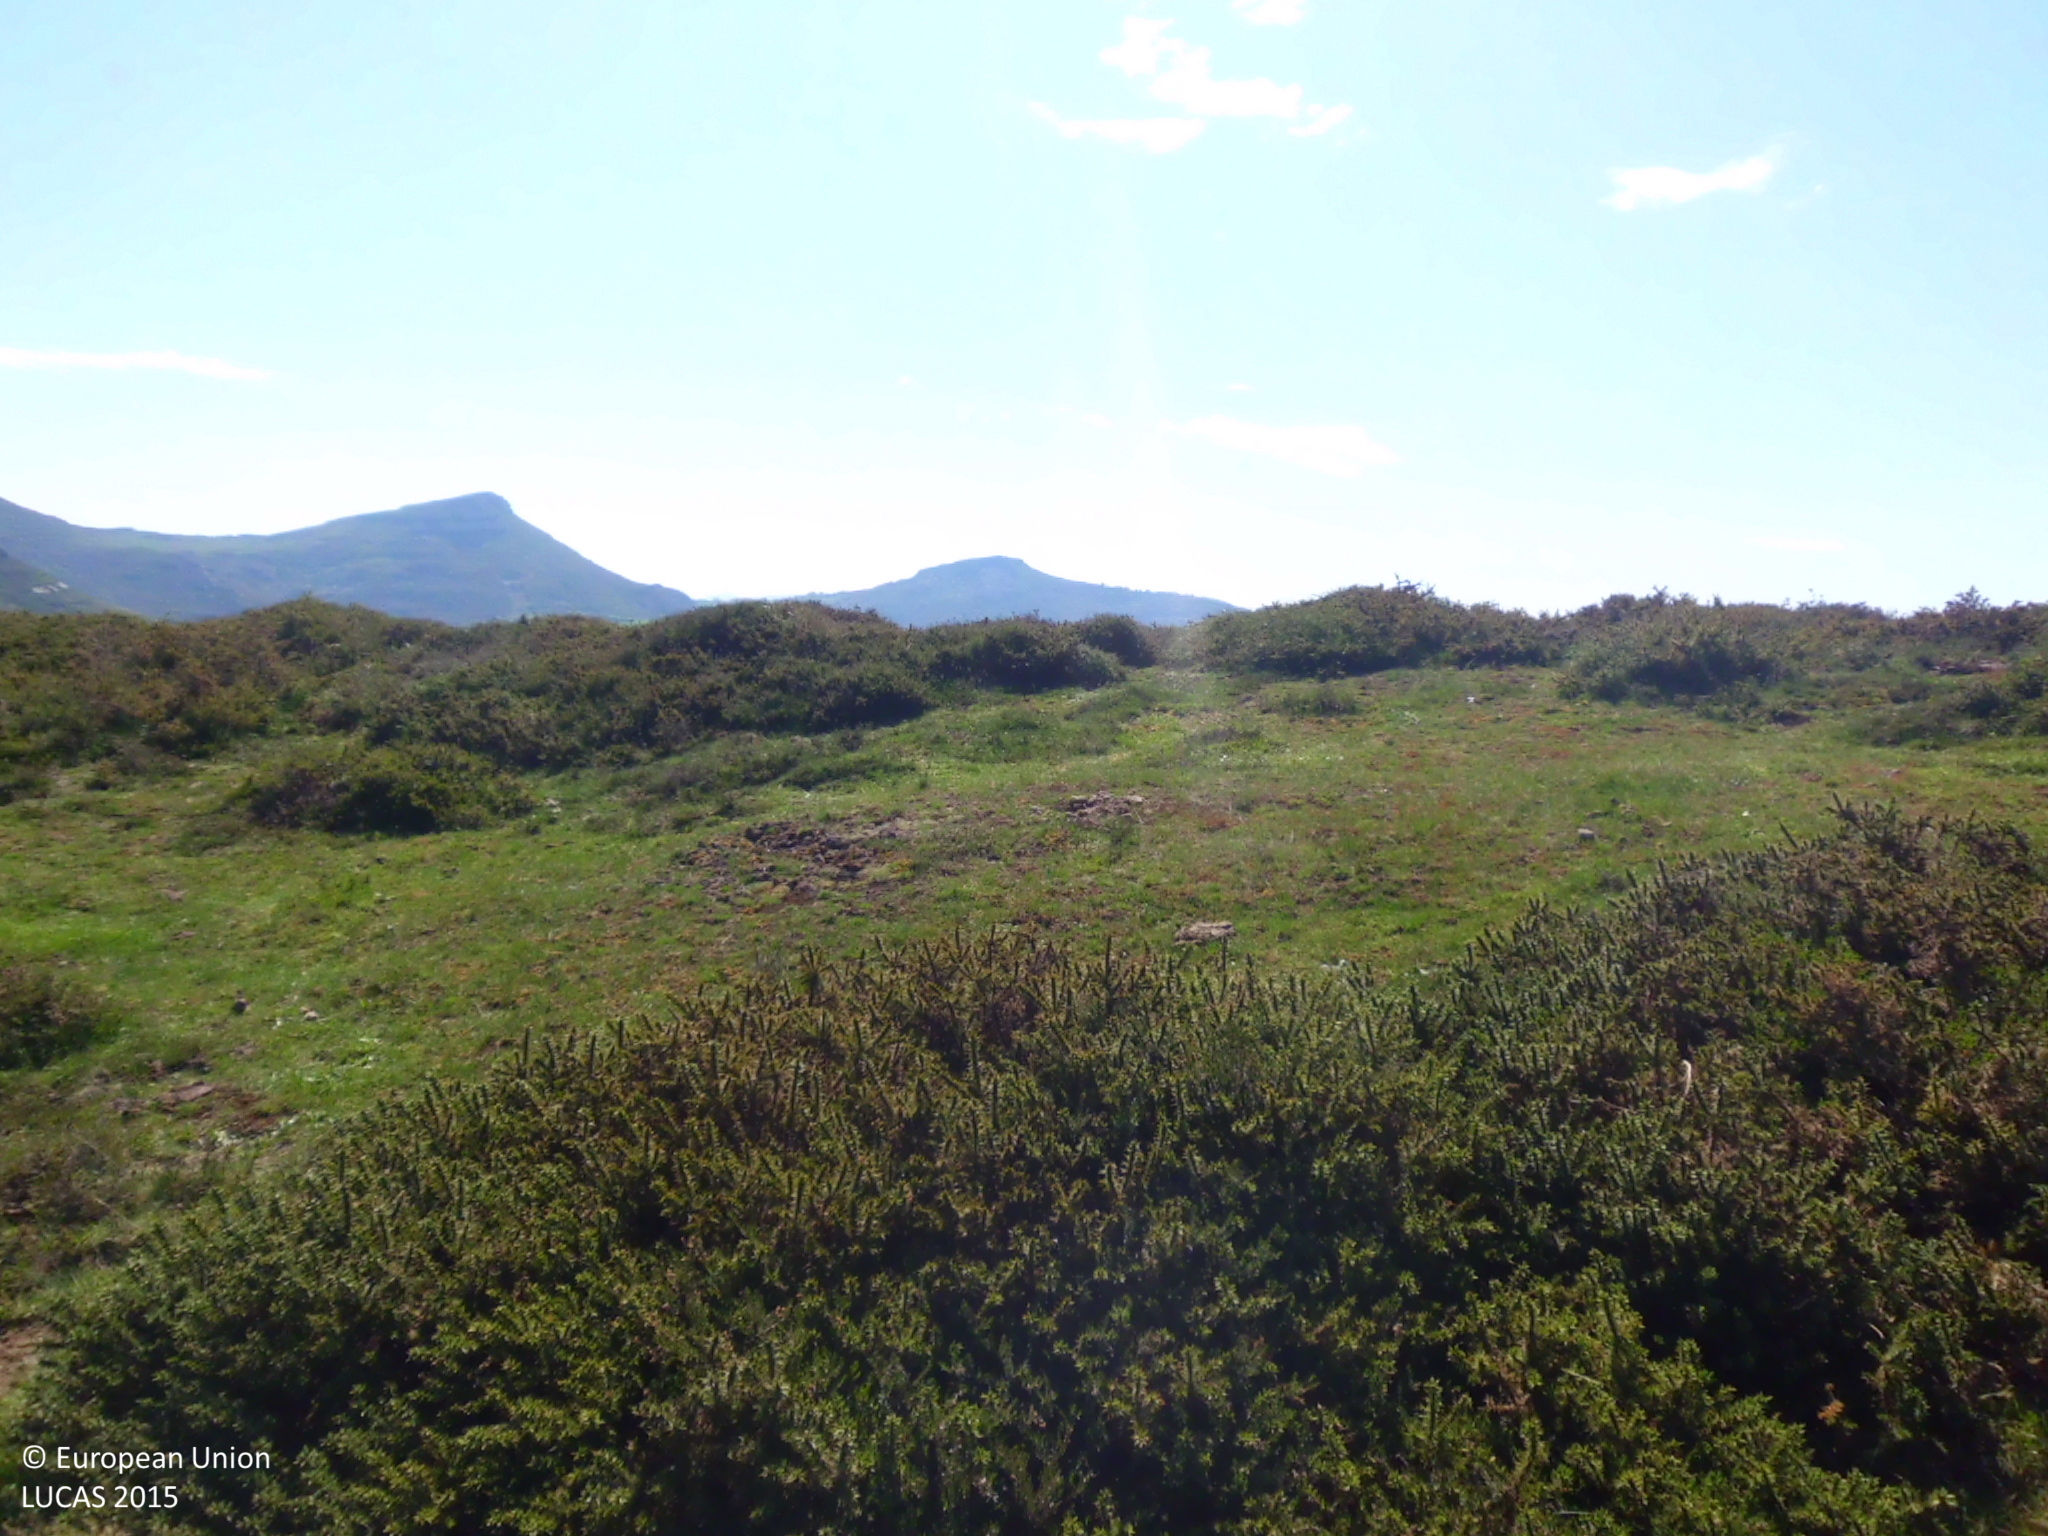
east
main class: Shrubland
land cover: Shrubland without tree cover
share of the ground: > 75 %
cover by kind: shrubs 80 %, herbaceous plants 20 %
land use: Semi-natural and natural areas not in use
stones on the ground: 25 - 50 %
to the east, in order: Shrubland without tree cover; Fences; Shrubland without tree cover; Paved roads, cycling and walking lanes; Broadleaved woodland
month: May
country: ES
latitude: 42.9338
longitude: -3.9044
